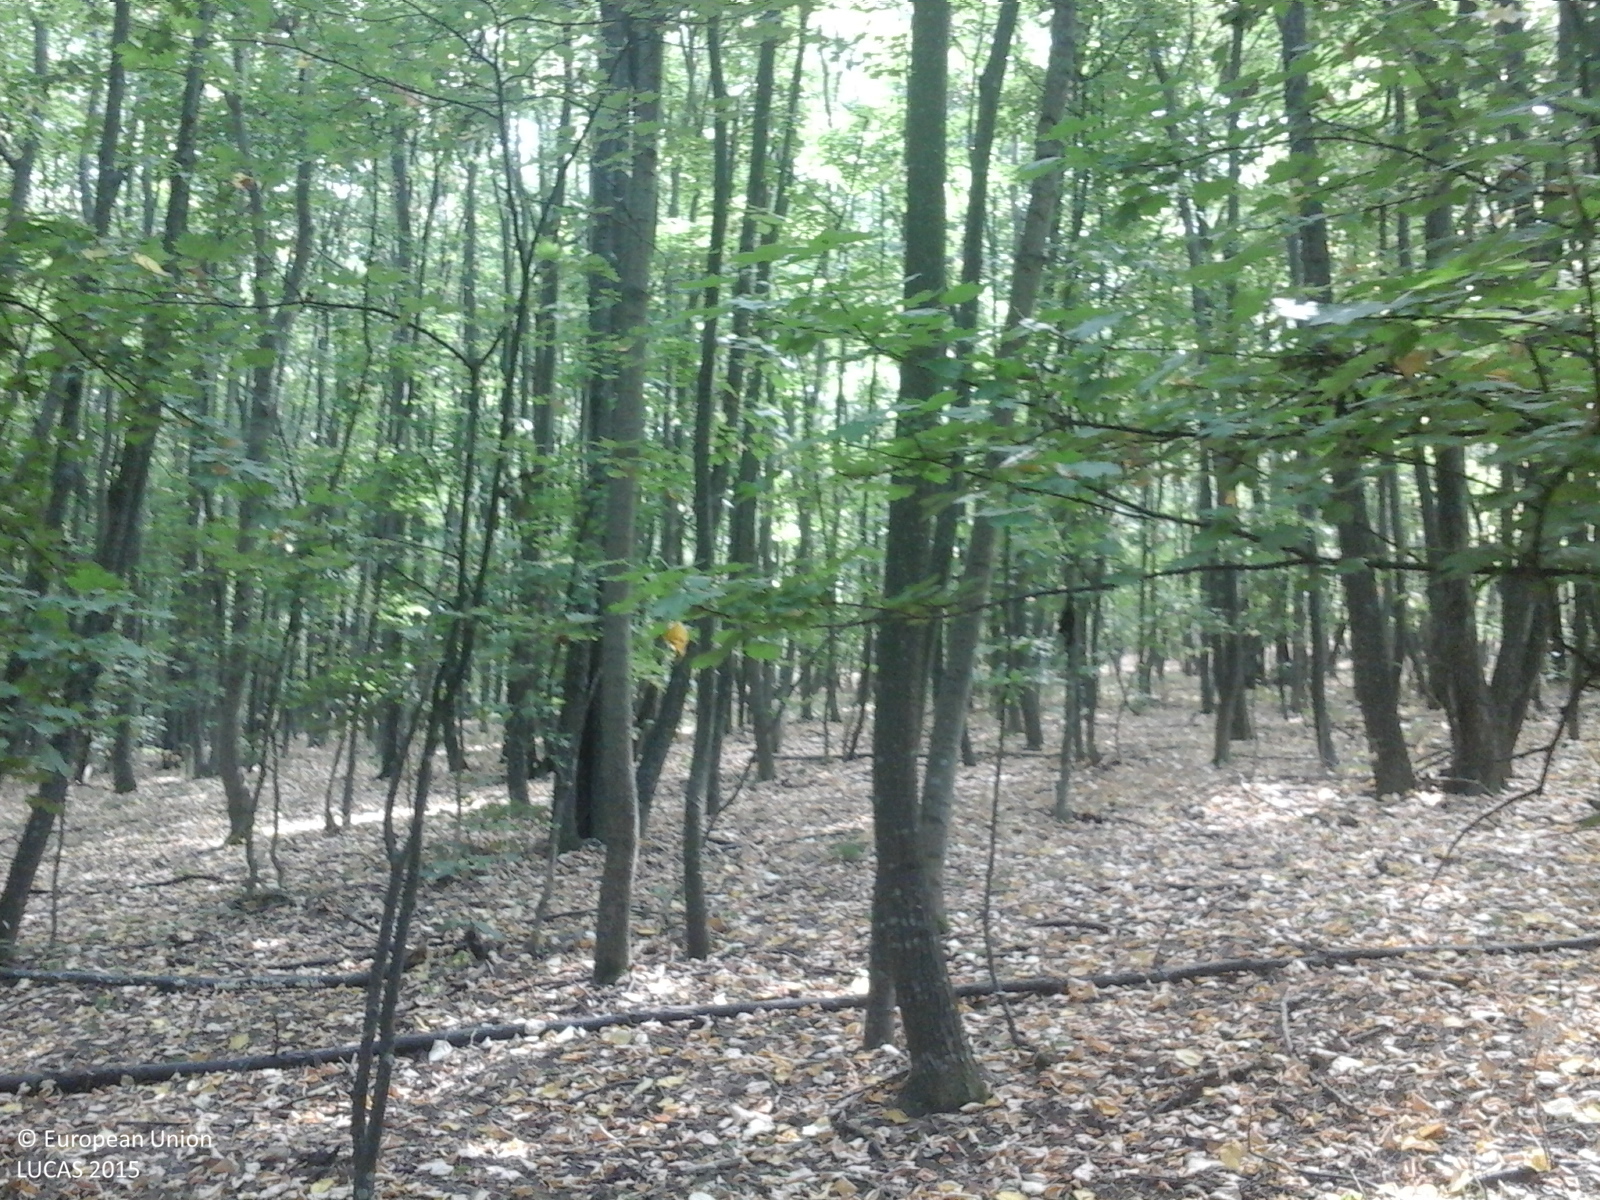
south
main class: Woodland
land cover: Broadleaved woodland
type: mesophytic deciduous forest
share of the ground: > 75 %
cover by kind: broadleaved forest trees 100 %
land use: Forestry
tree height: > 5 m
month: July
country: RO
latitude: 45.1423
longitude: 28.5072
